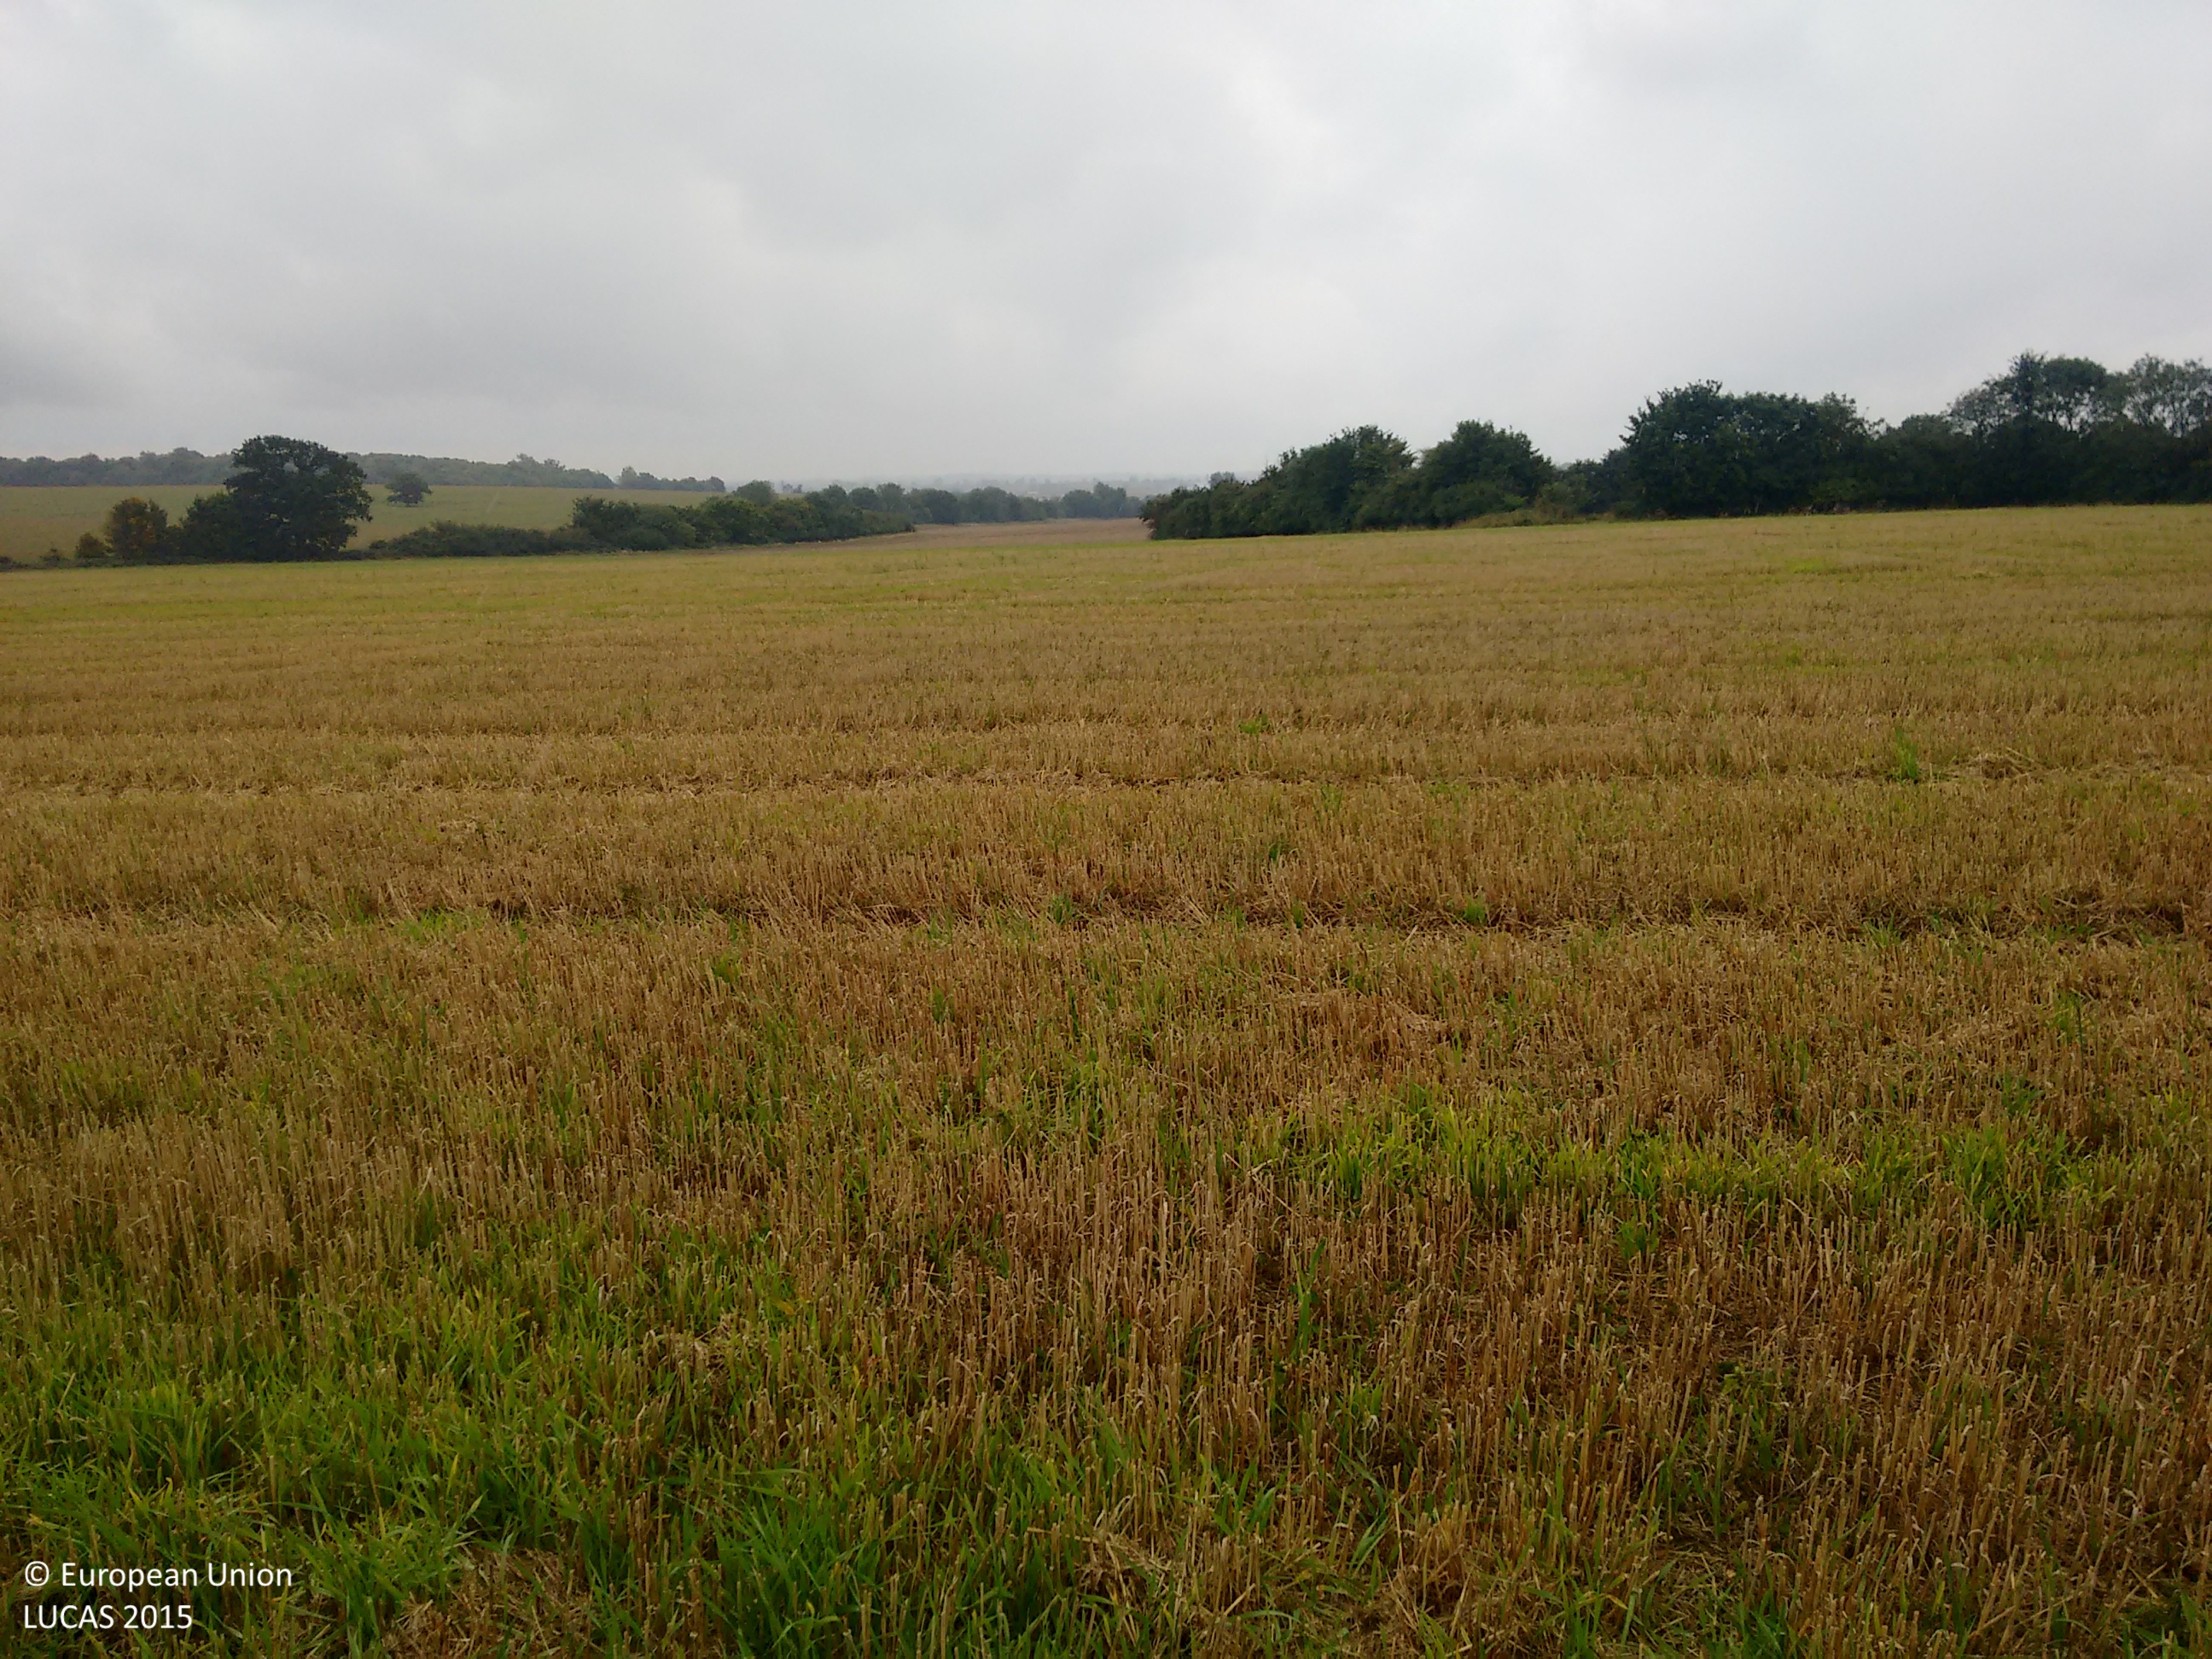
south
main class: Cropland
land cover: Barley
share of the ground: > 75 %
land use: Agriculture (excluding fallow land and kitchen gardens)
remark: Harvested field
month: September
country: GB
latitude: 51.9428
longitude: 0.2963
